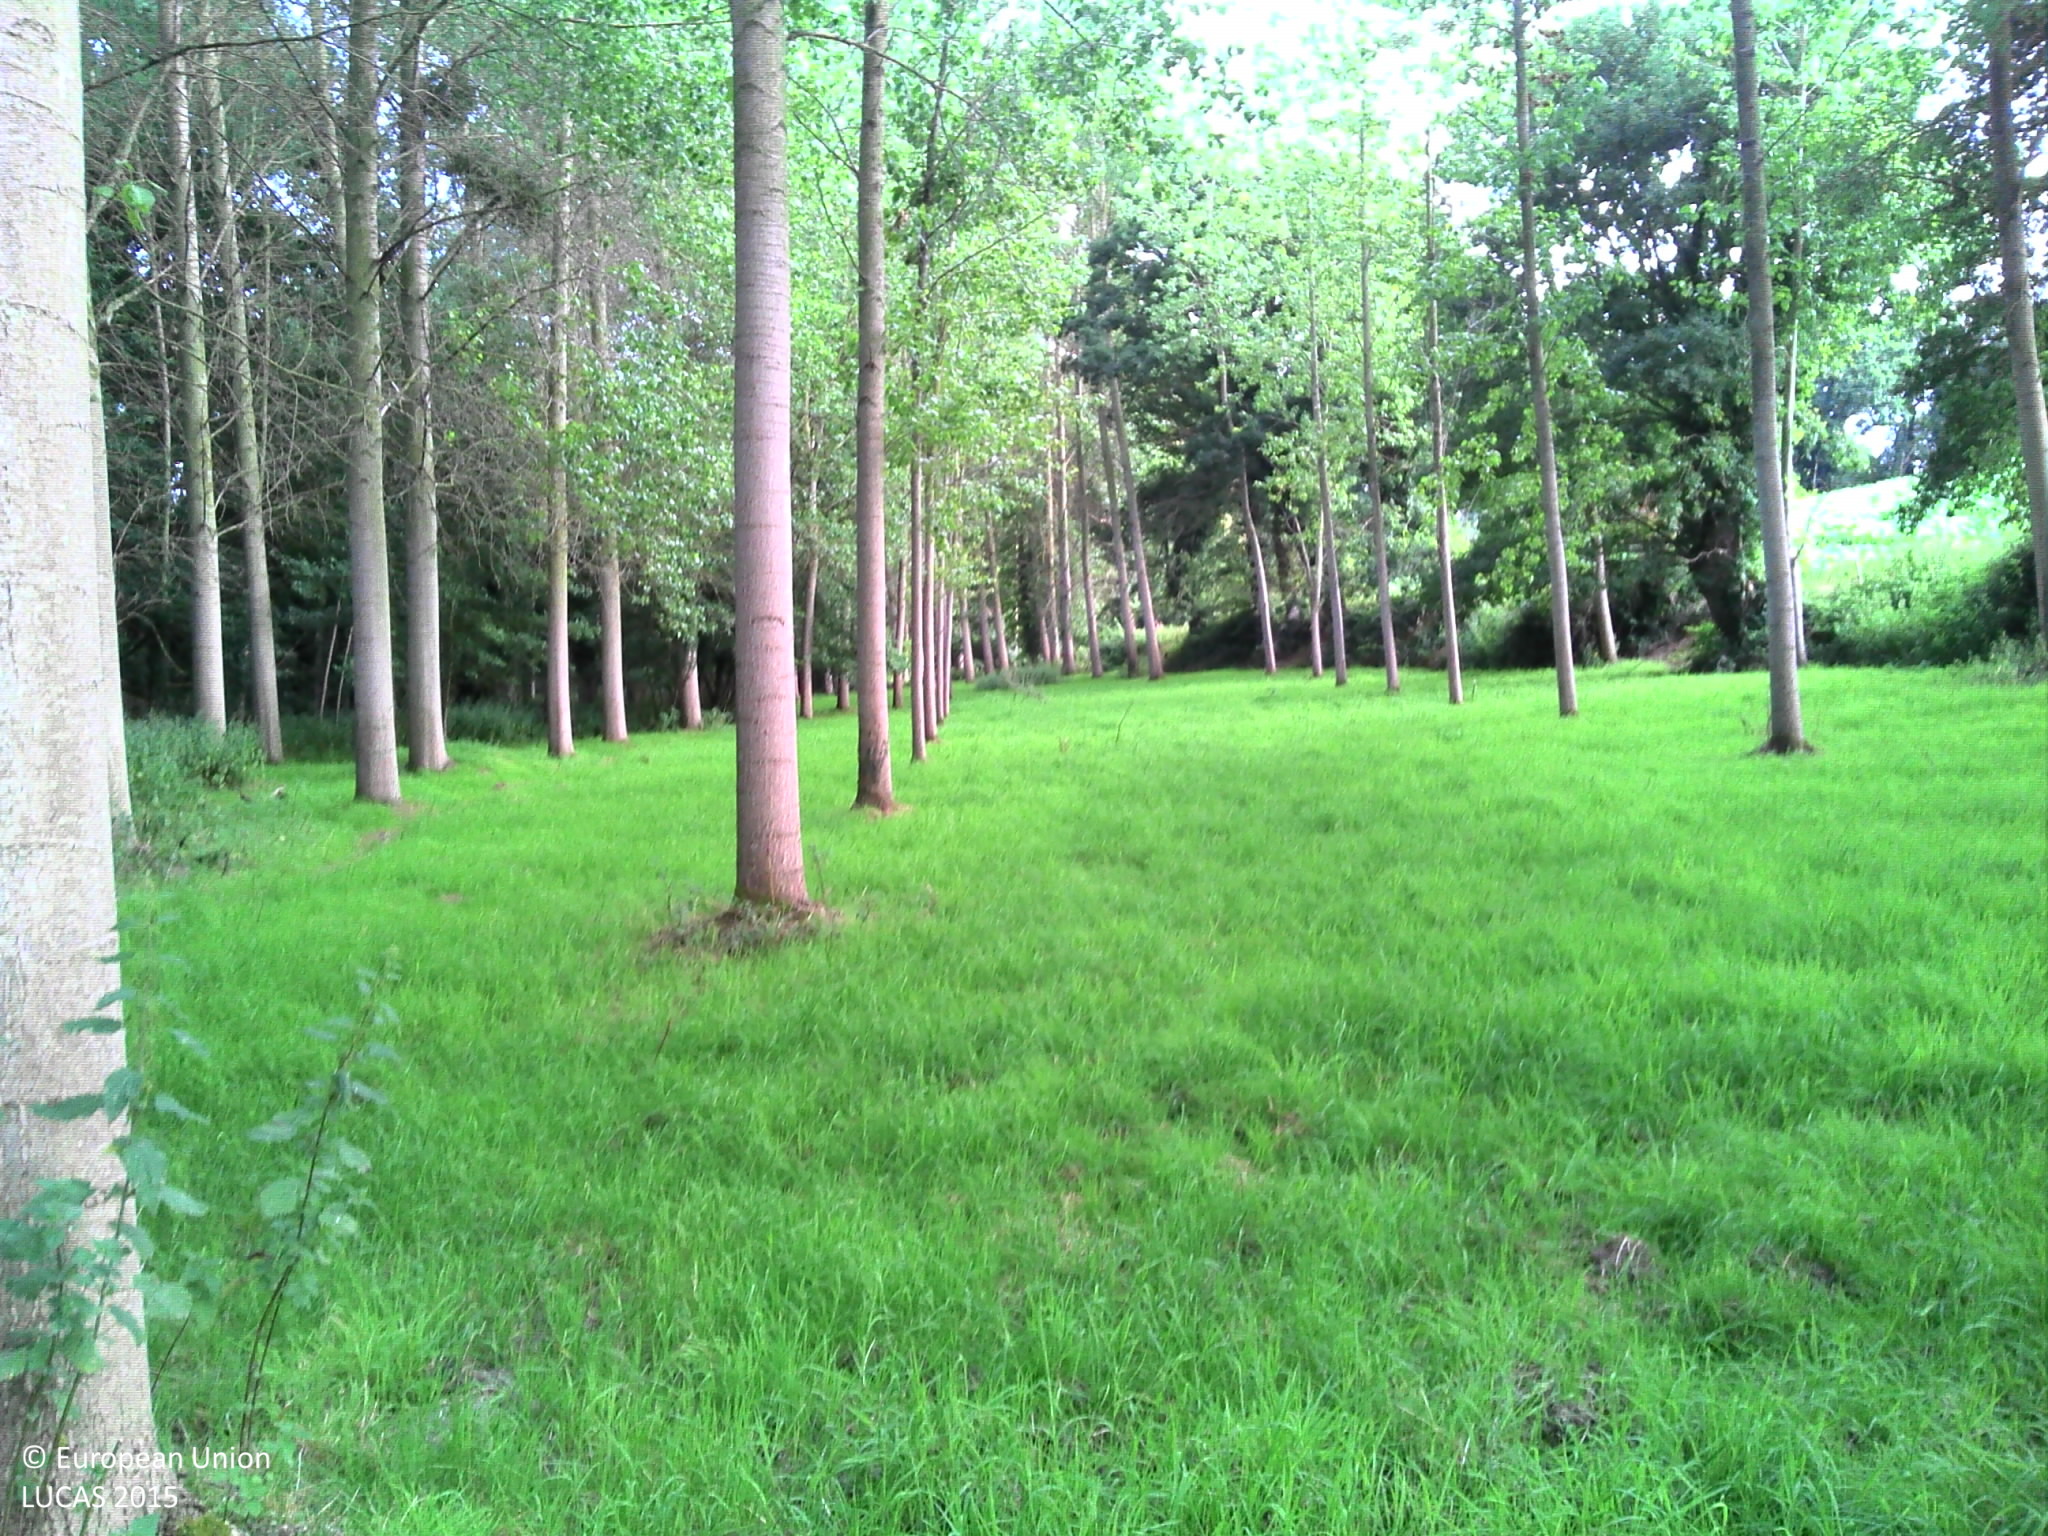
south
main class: Woodland
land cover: Broadleaved woodland
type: exotic forest
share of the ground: > 75 %
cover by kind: herbaceous plants 70 %, broadleaved forest trees 20 %, unconsolidated bare surface 10 %
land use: Forestry
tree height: > 5 m
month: July
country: FR
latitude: 48.4214
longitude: -2.4794
